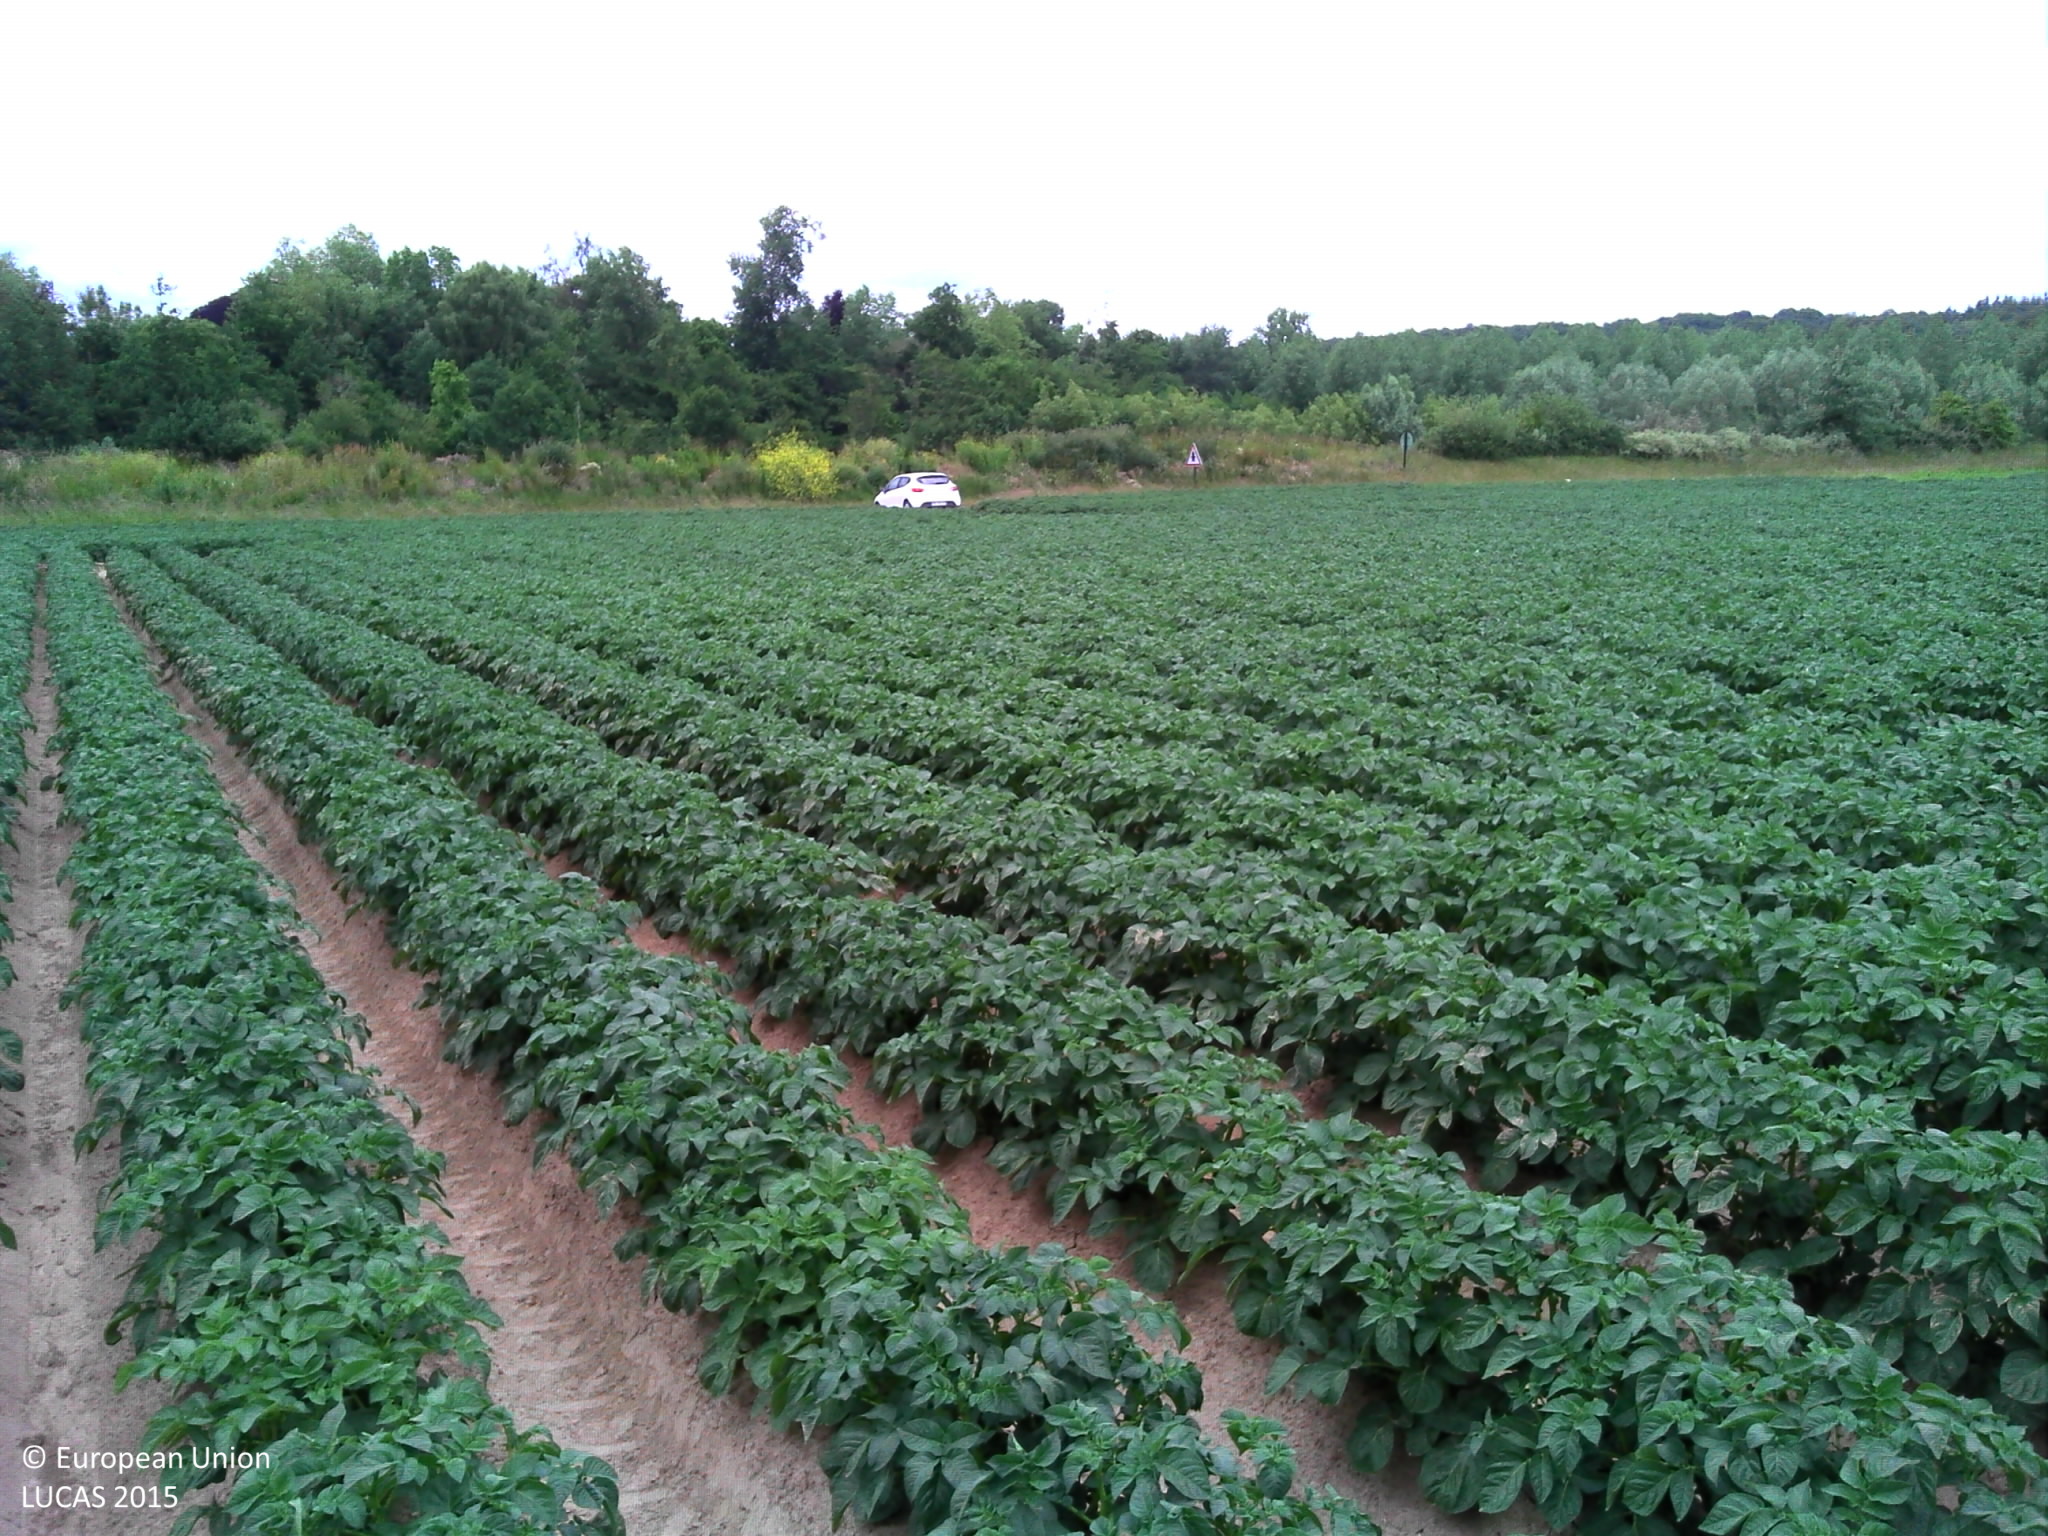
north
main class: Cropland
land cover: Potatoes
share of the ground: > 75 %
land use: Agriculture (excluding fallow land and kitchen gardens)
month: June
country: FR
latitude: 50.6843
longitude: 2.3292
